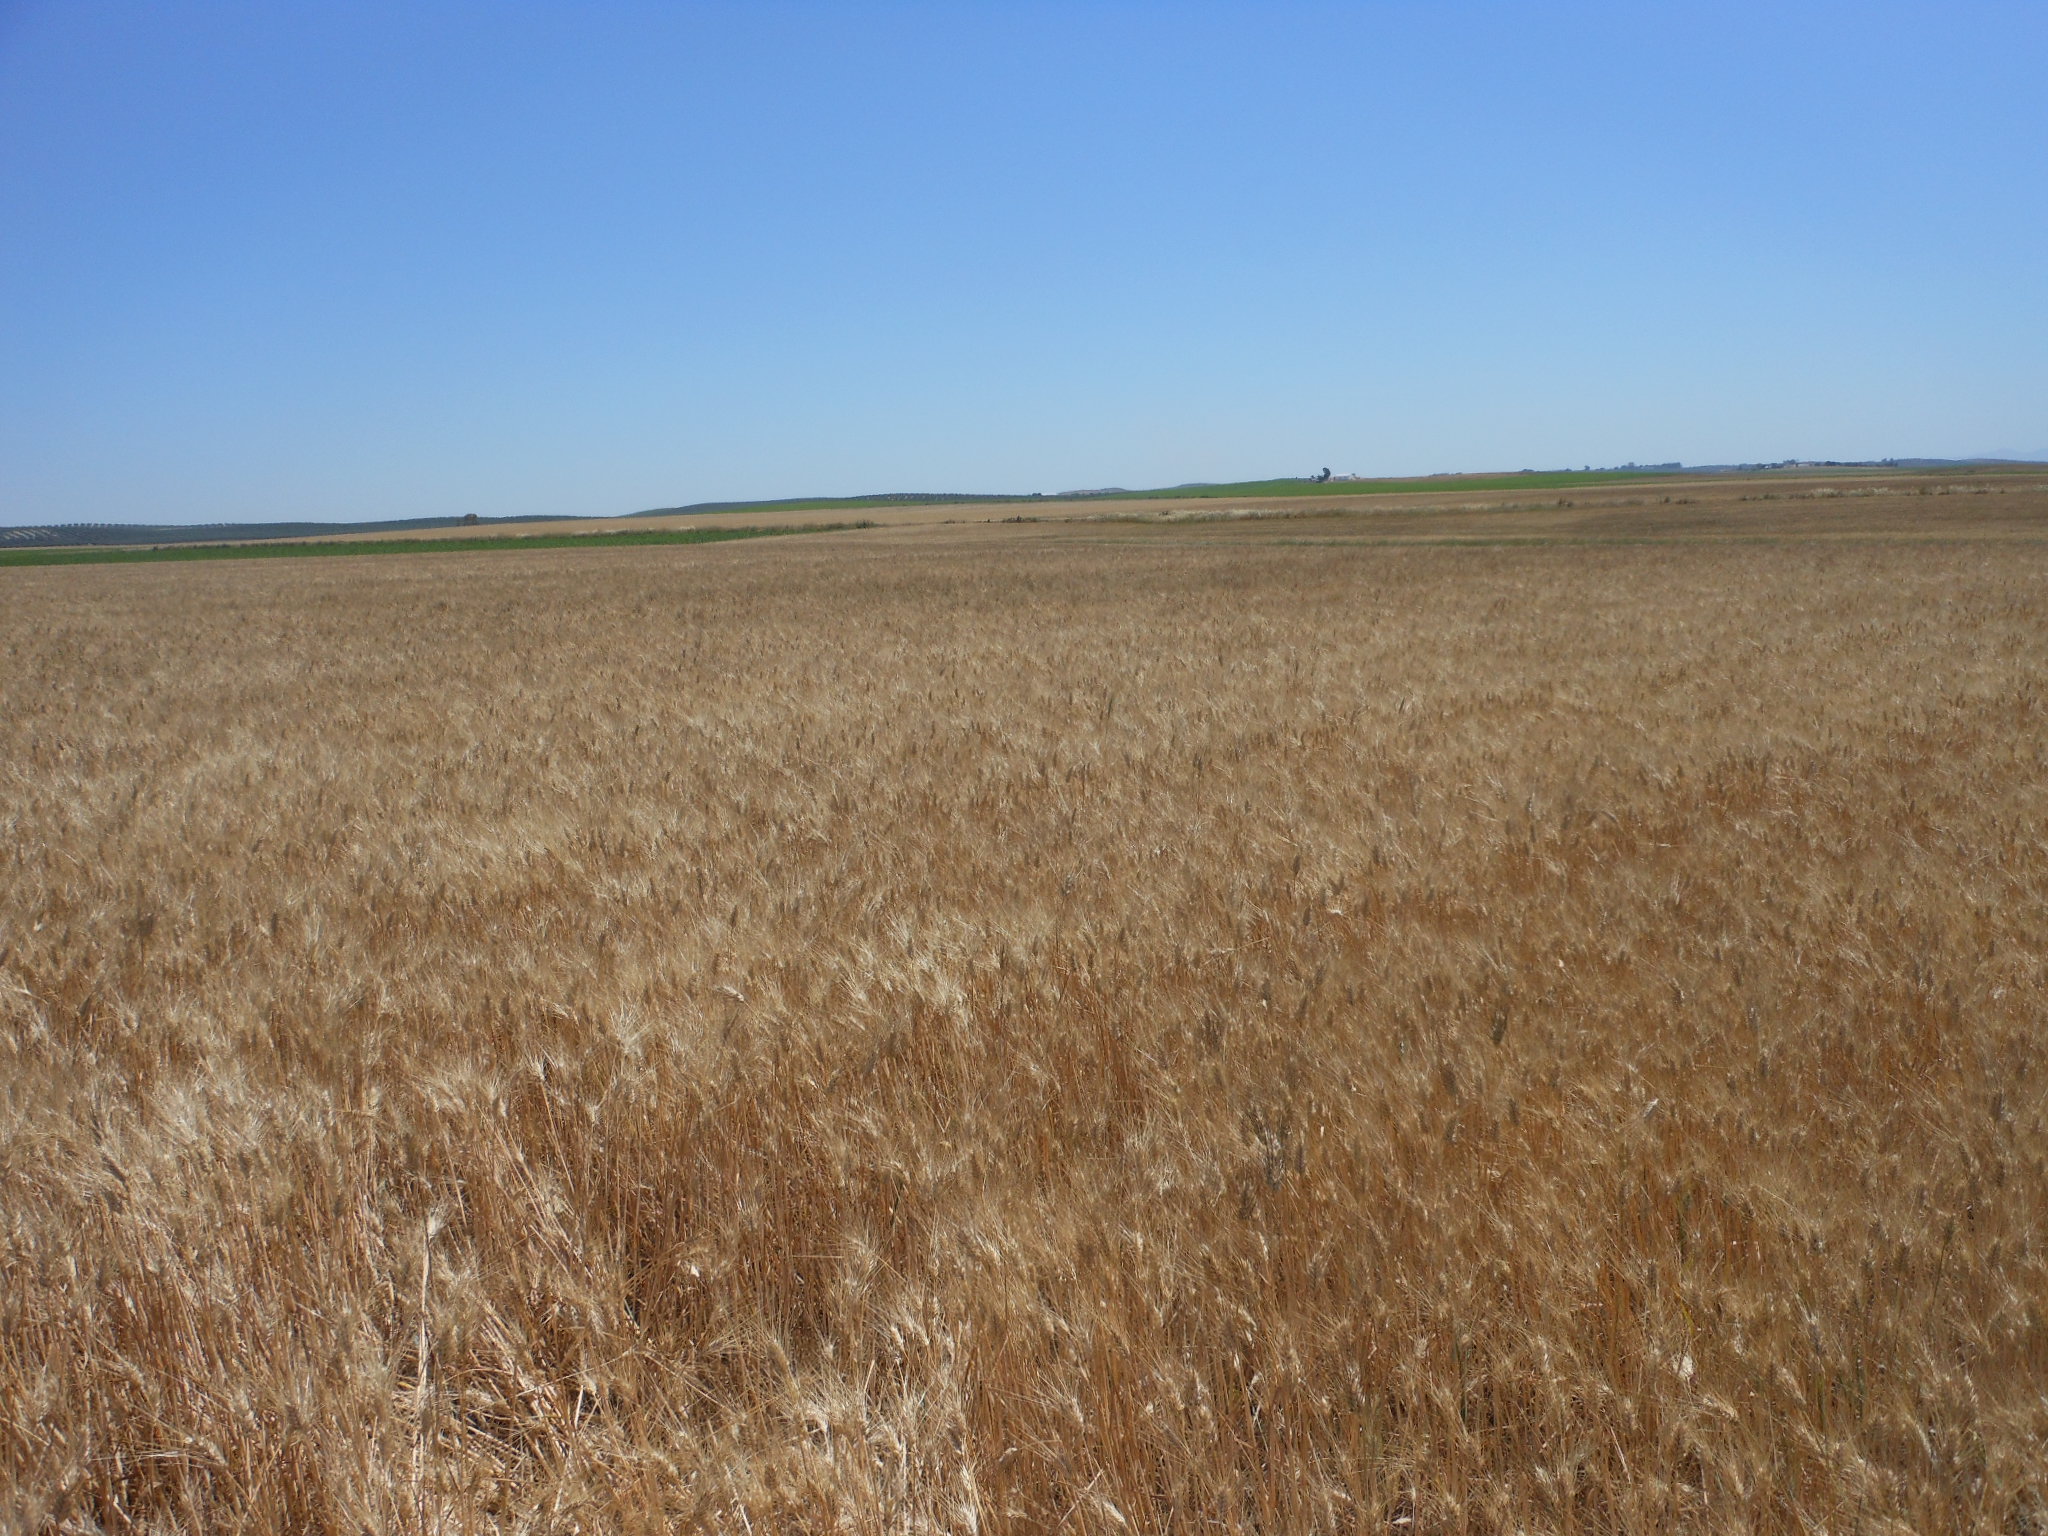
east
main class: Cropland
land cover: Durum wheat
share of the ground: > 75 %
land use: Agriculture (excluding fallow land and kitchen gardens)
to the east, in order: Durum wheat; Grass margins; Rivers and streams; Grass margins; Durum wheat; Grass margins; Tracks; Grass margins; Common wheat
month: May
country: ES
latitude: 37.3745
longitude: -5.5896
